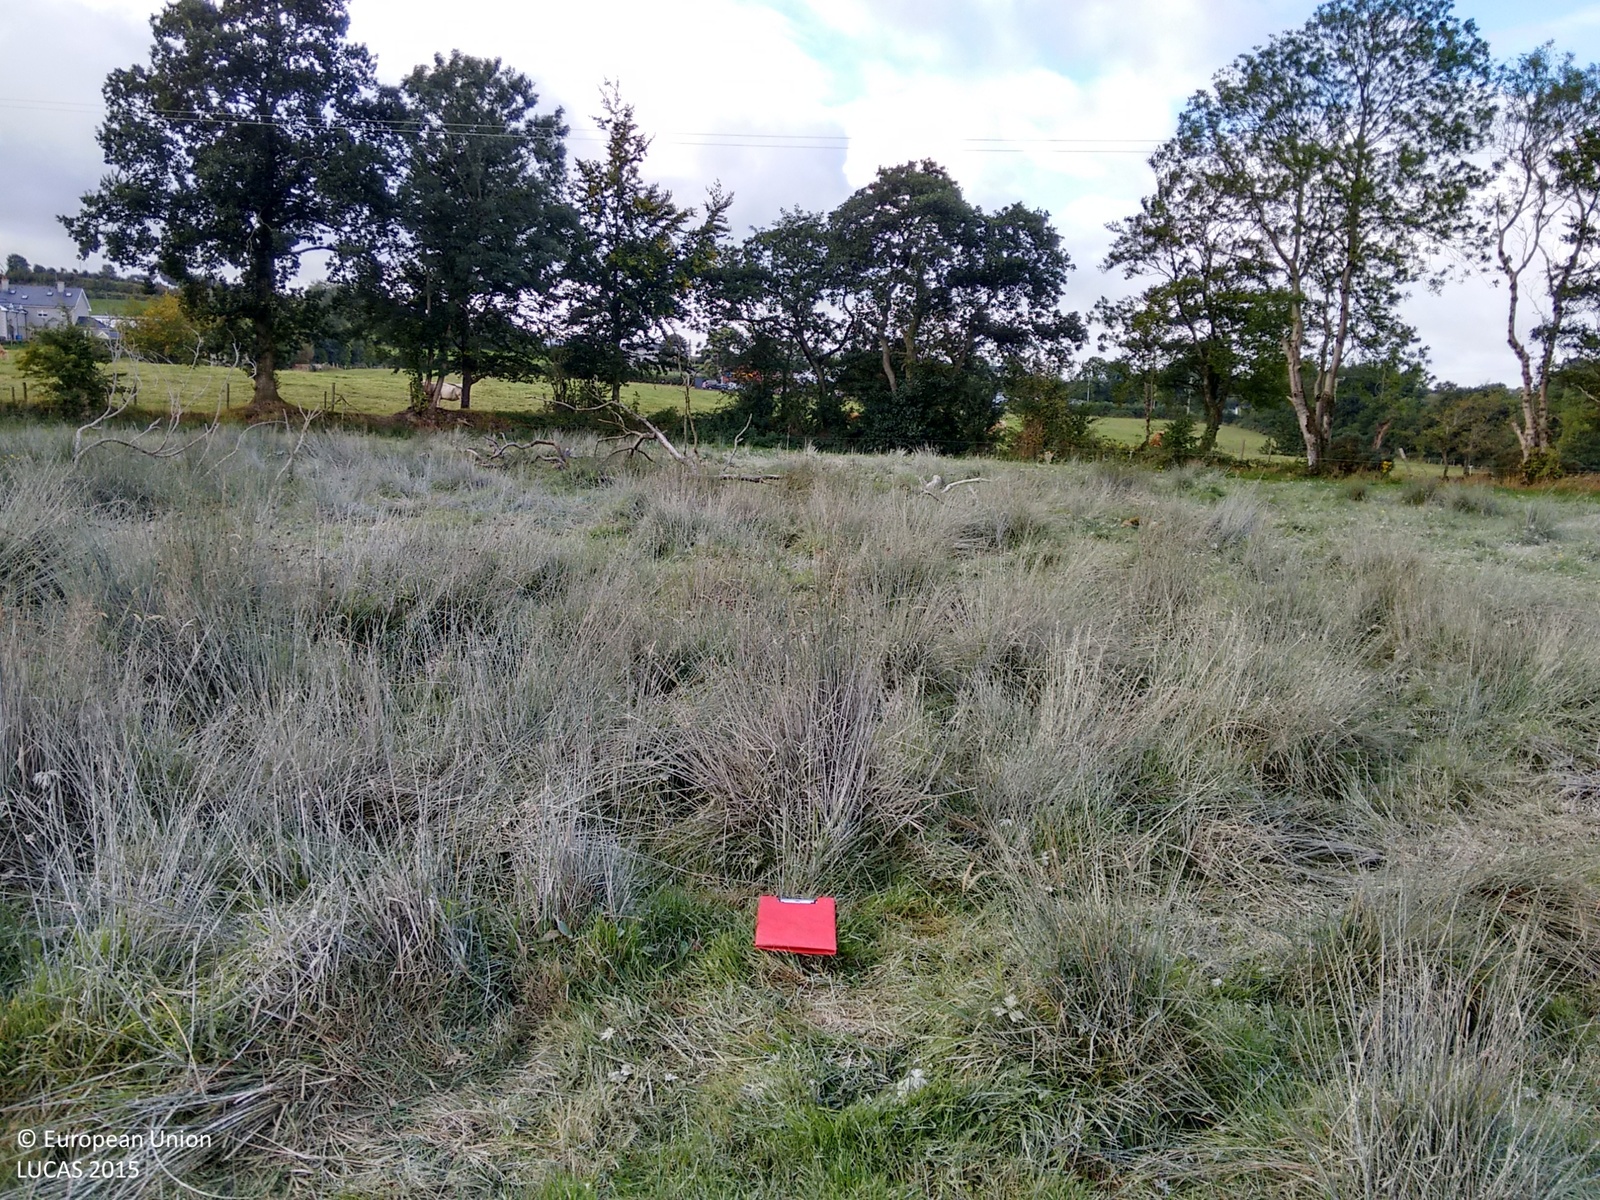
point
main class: Grassland
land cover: Grassland without tree/shrub cover
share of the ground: > 75 %
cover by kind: herbaceous plants 100 %
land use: Agriculture (excluding fallow land and kitchen gardens)
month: September
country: IE
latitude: 54.1987
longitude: -6.8281
